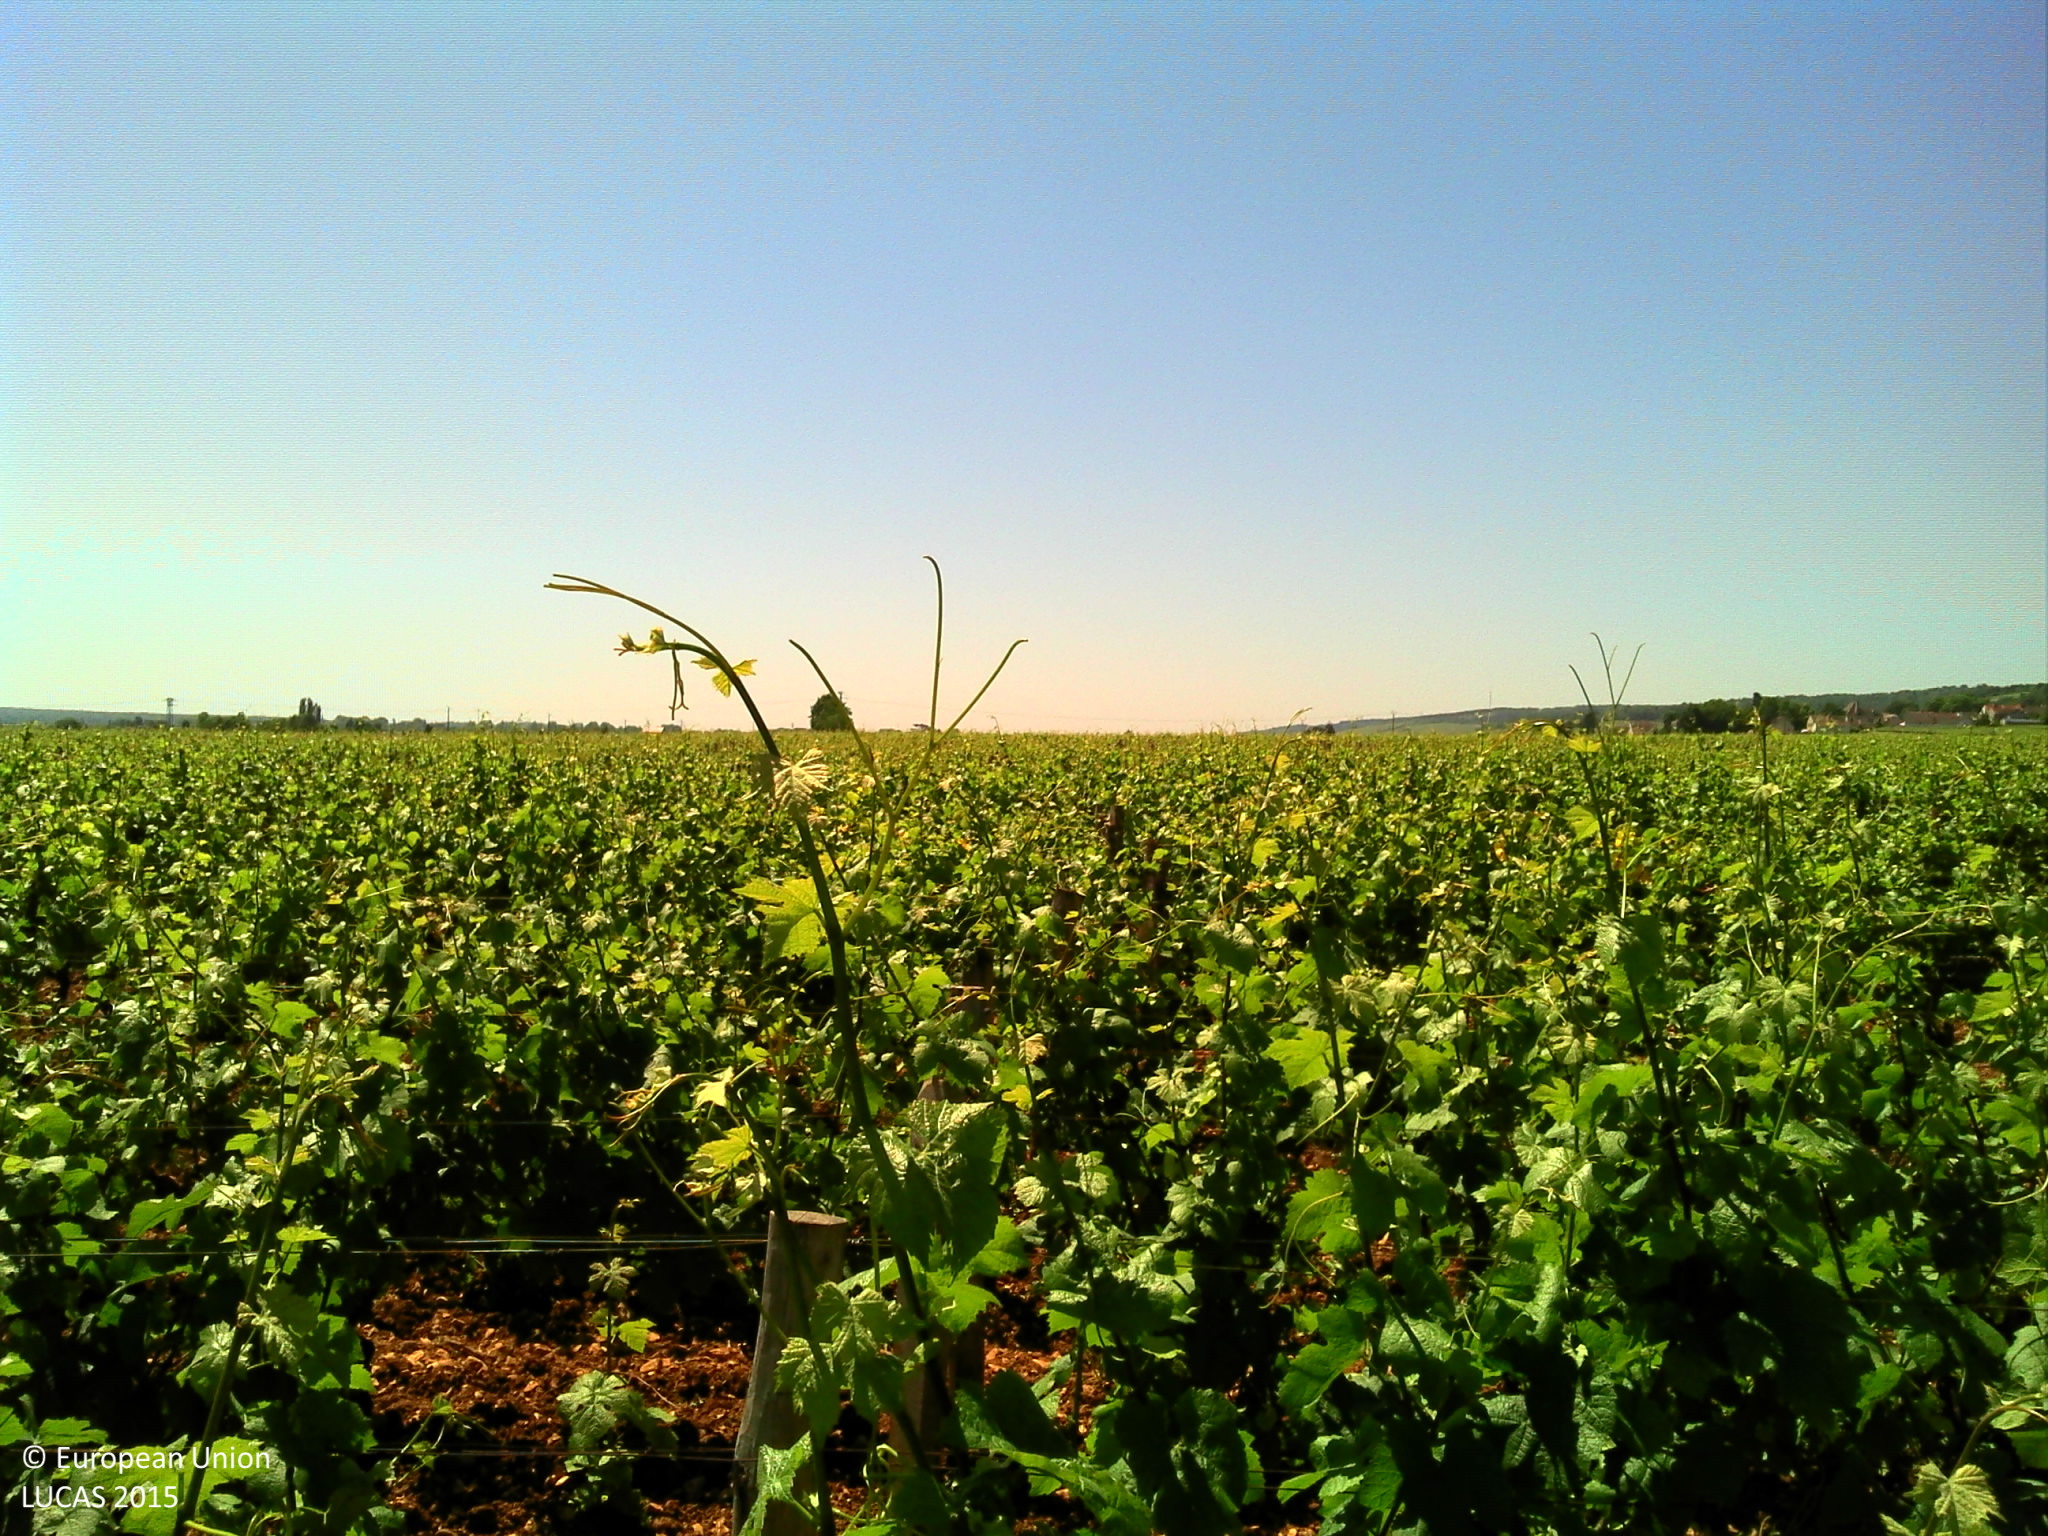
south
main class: Cropland
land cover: Vineyards
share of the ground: 50 - 75 %
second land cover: Other bare soil
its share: > 75 %
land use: Agriculture (excluding fallow land and kitchen gardens)
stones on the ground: > 50 %
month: June
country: FR
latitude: 47.2071
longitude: 4.9706
